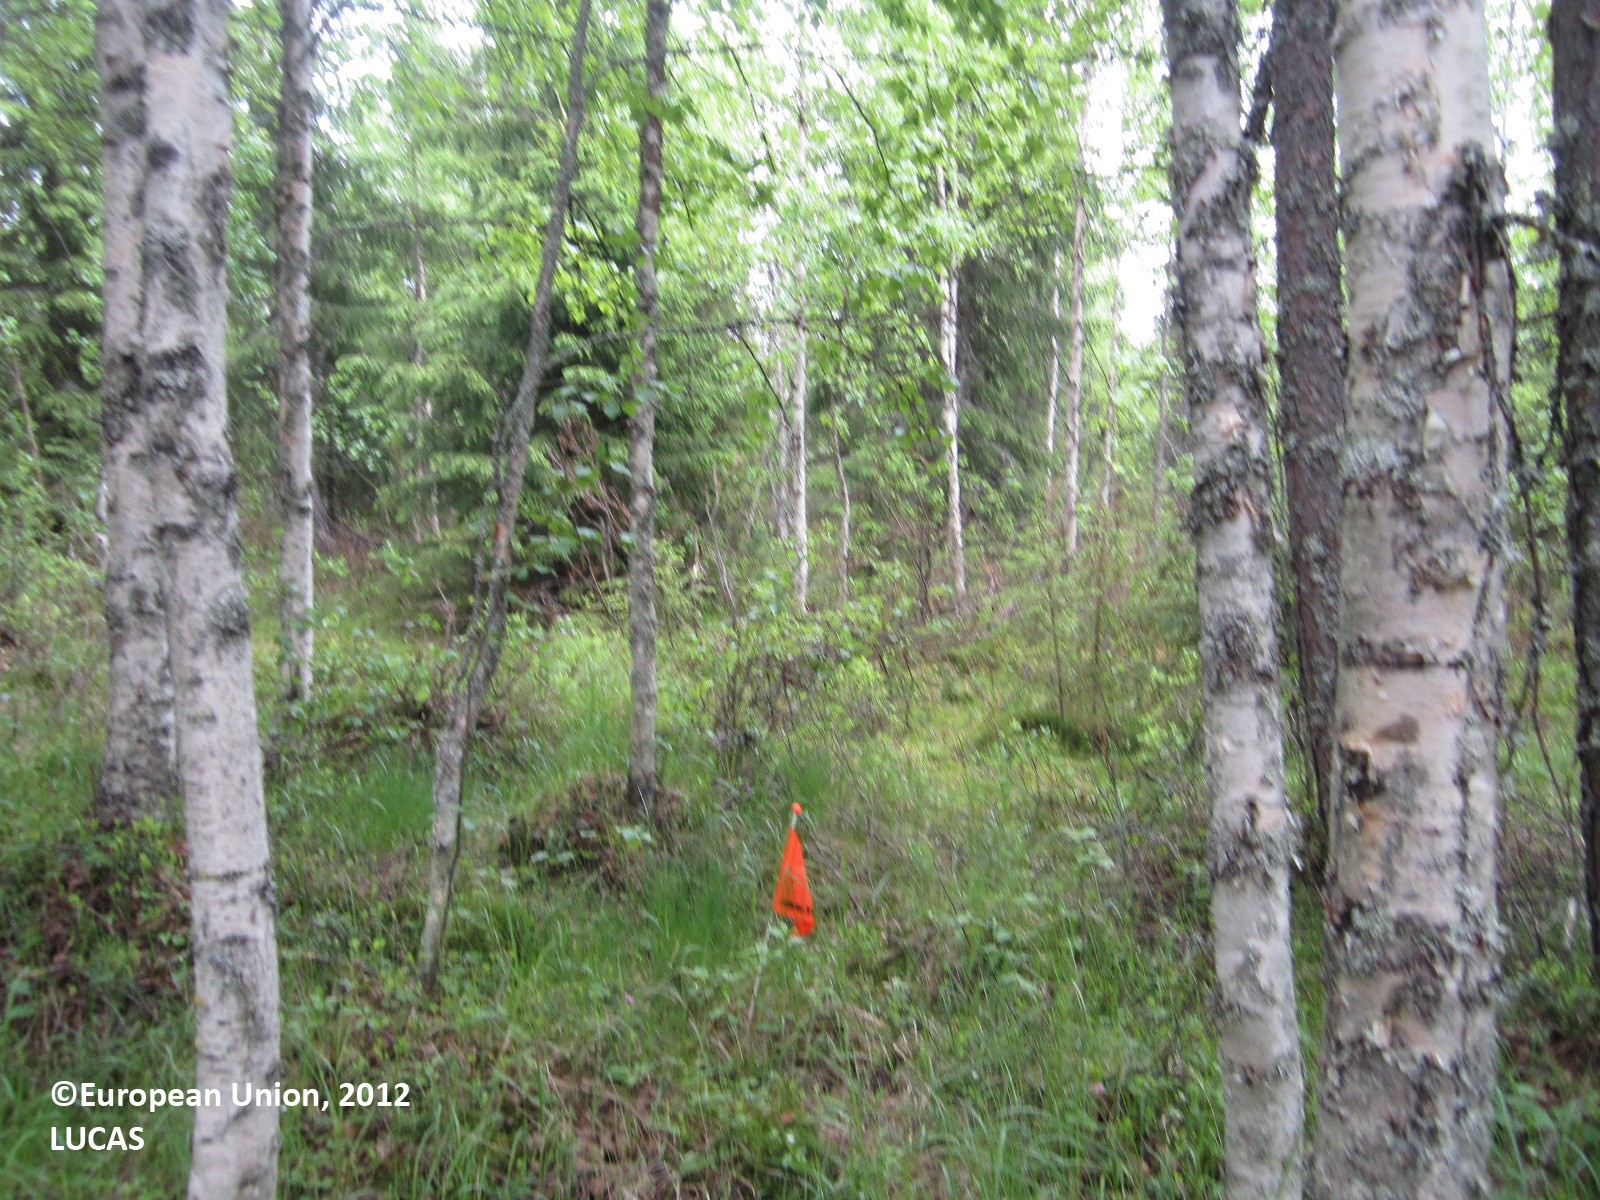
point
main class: Woodland
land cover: Broadleaved woodland
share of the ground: > 75 %
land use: Forestry
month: June
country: FI
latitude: 64.6990
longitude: 29.7007
